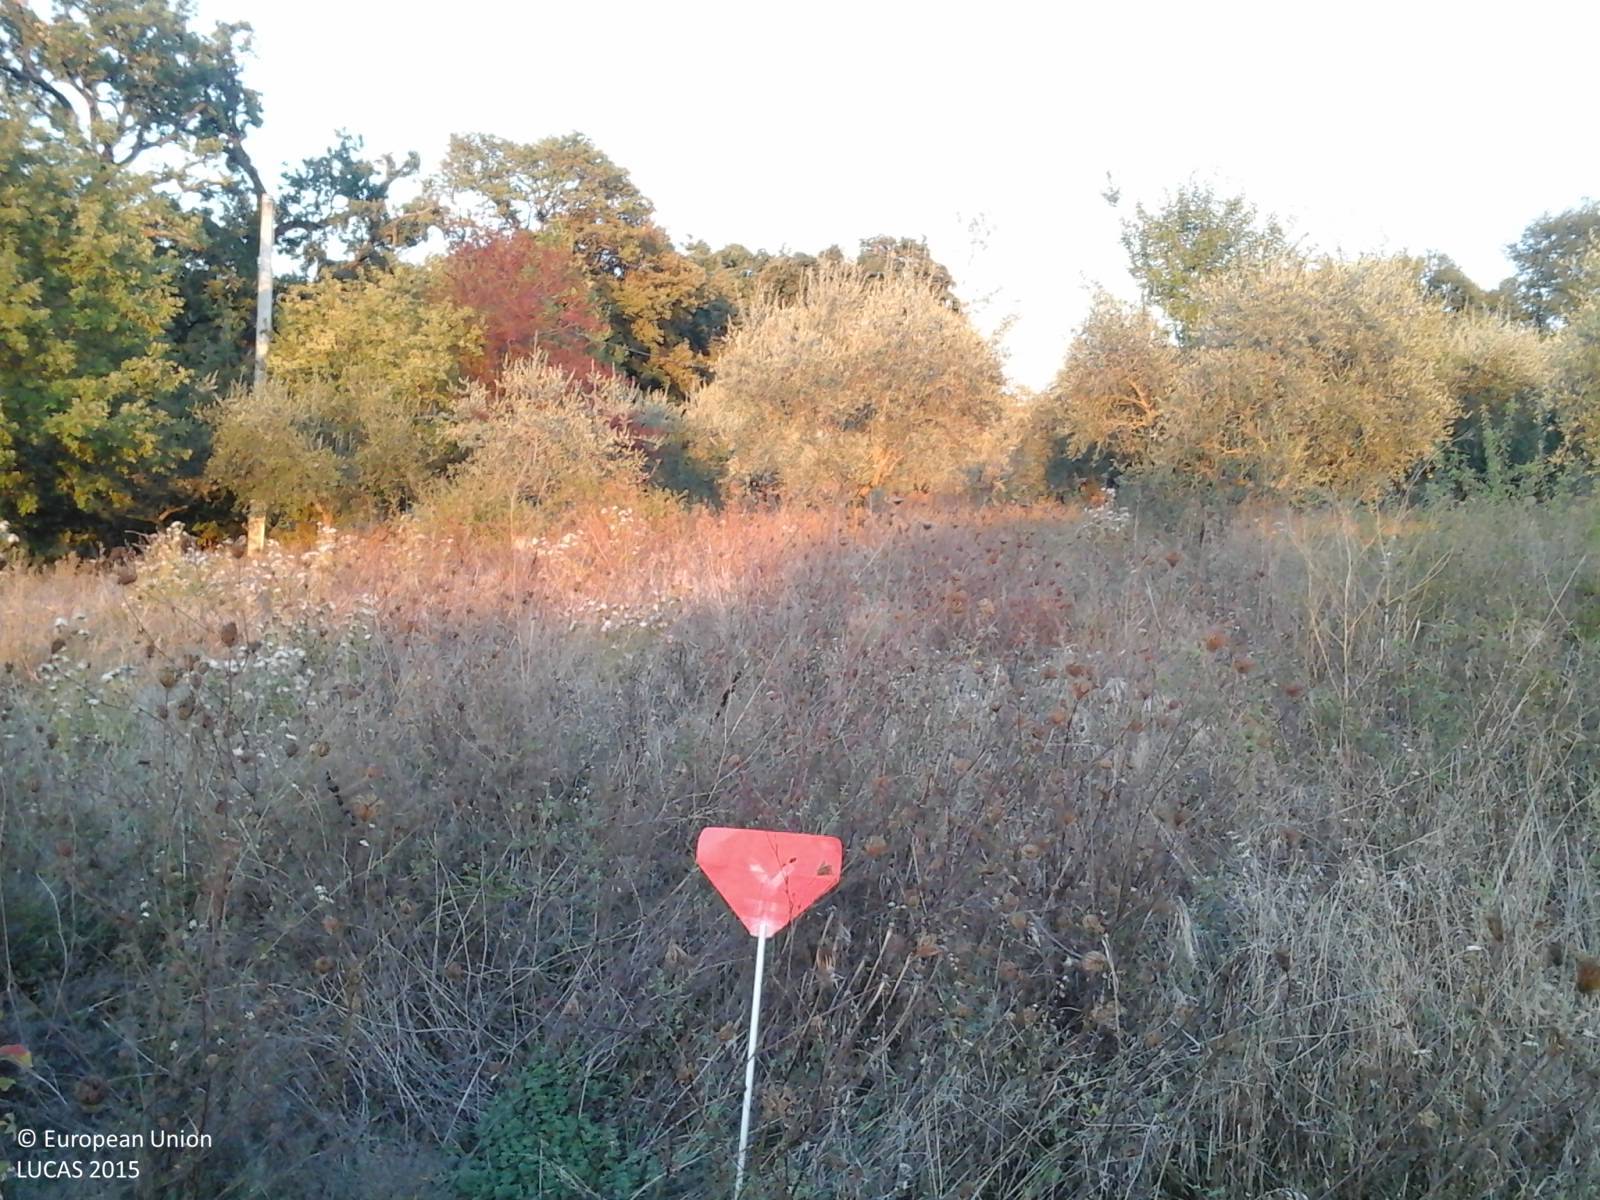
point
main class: Grassland
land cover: Spontaneously vegetated surfaces
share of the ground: > 75 %
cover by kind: herbaceous plants 100 %
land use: Abandoned areas
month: September
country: IT
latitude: 43.0775
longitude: 12.3881
